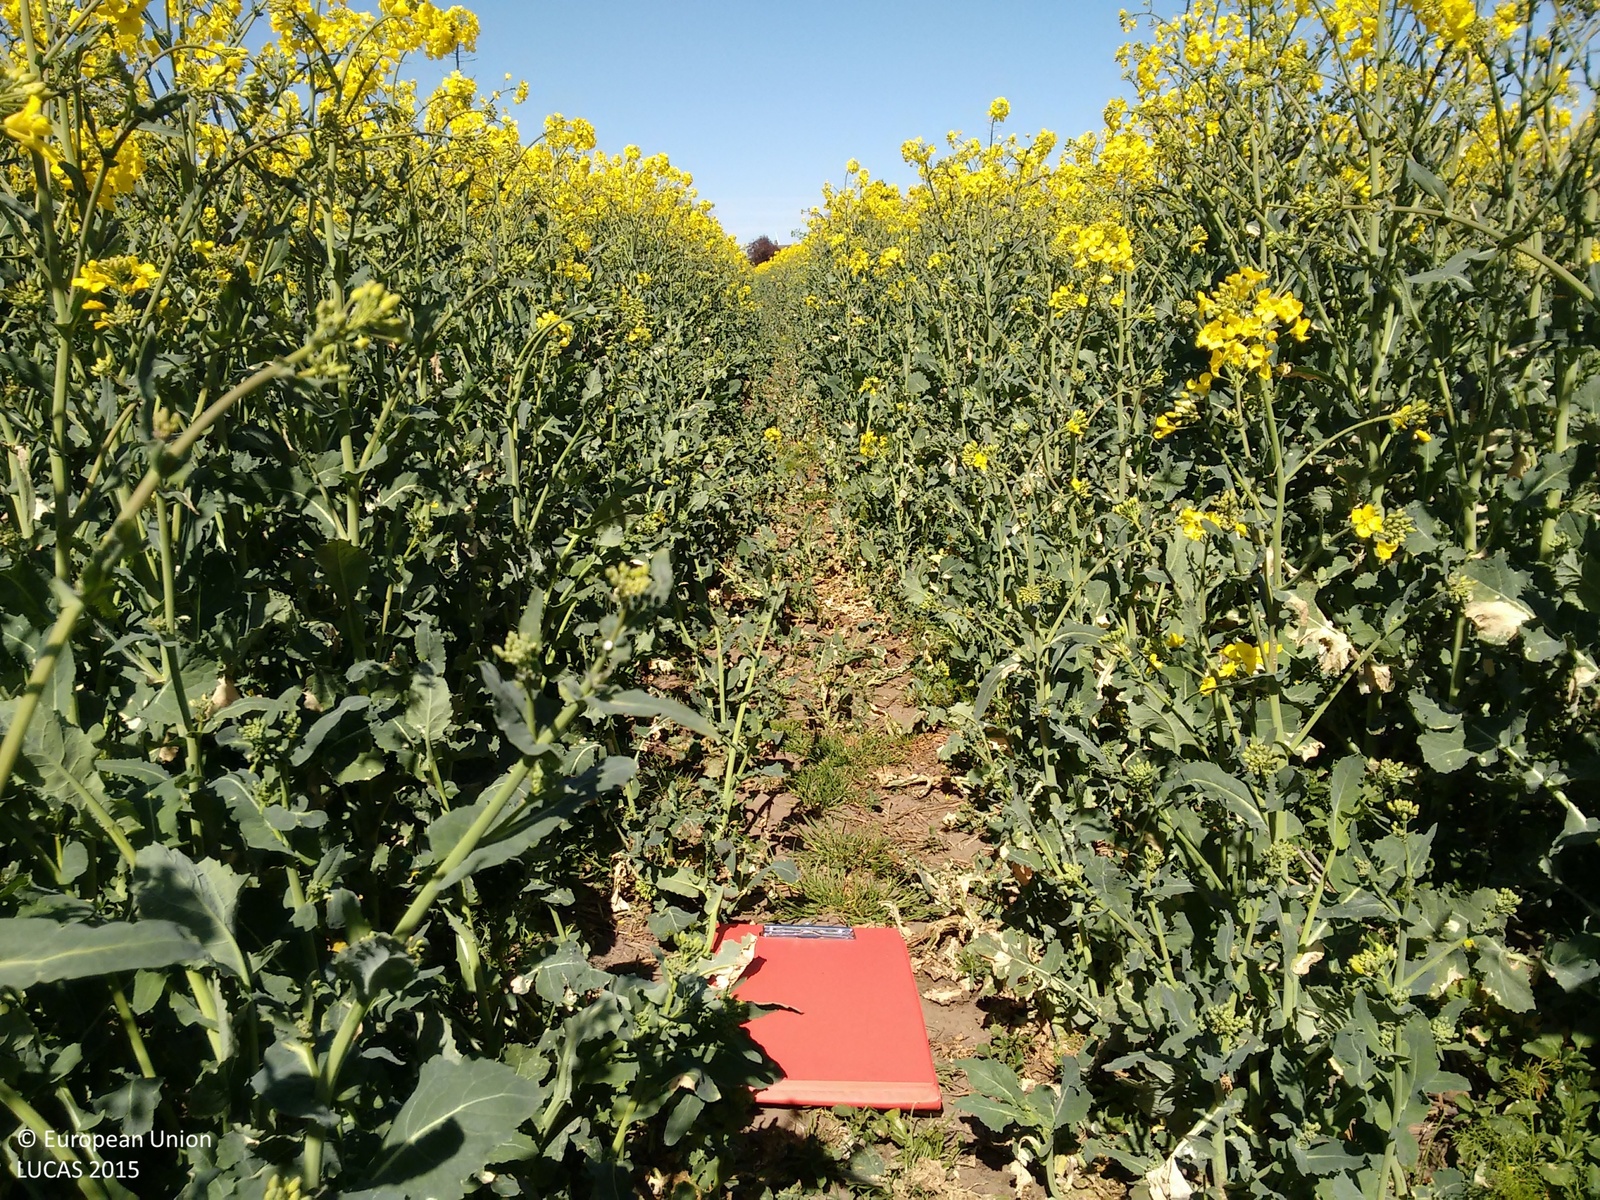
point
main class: Cropland
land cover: Rape and turnip rape
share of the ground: > 75 %
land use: Agriculture (excluding fallow land and kitchen gardens)
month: April
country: GB
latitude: 53.8237
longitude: -0.8113
